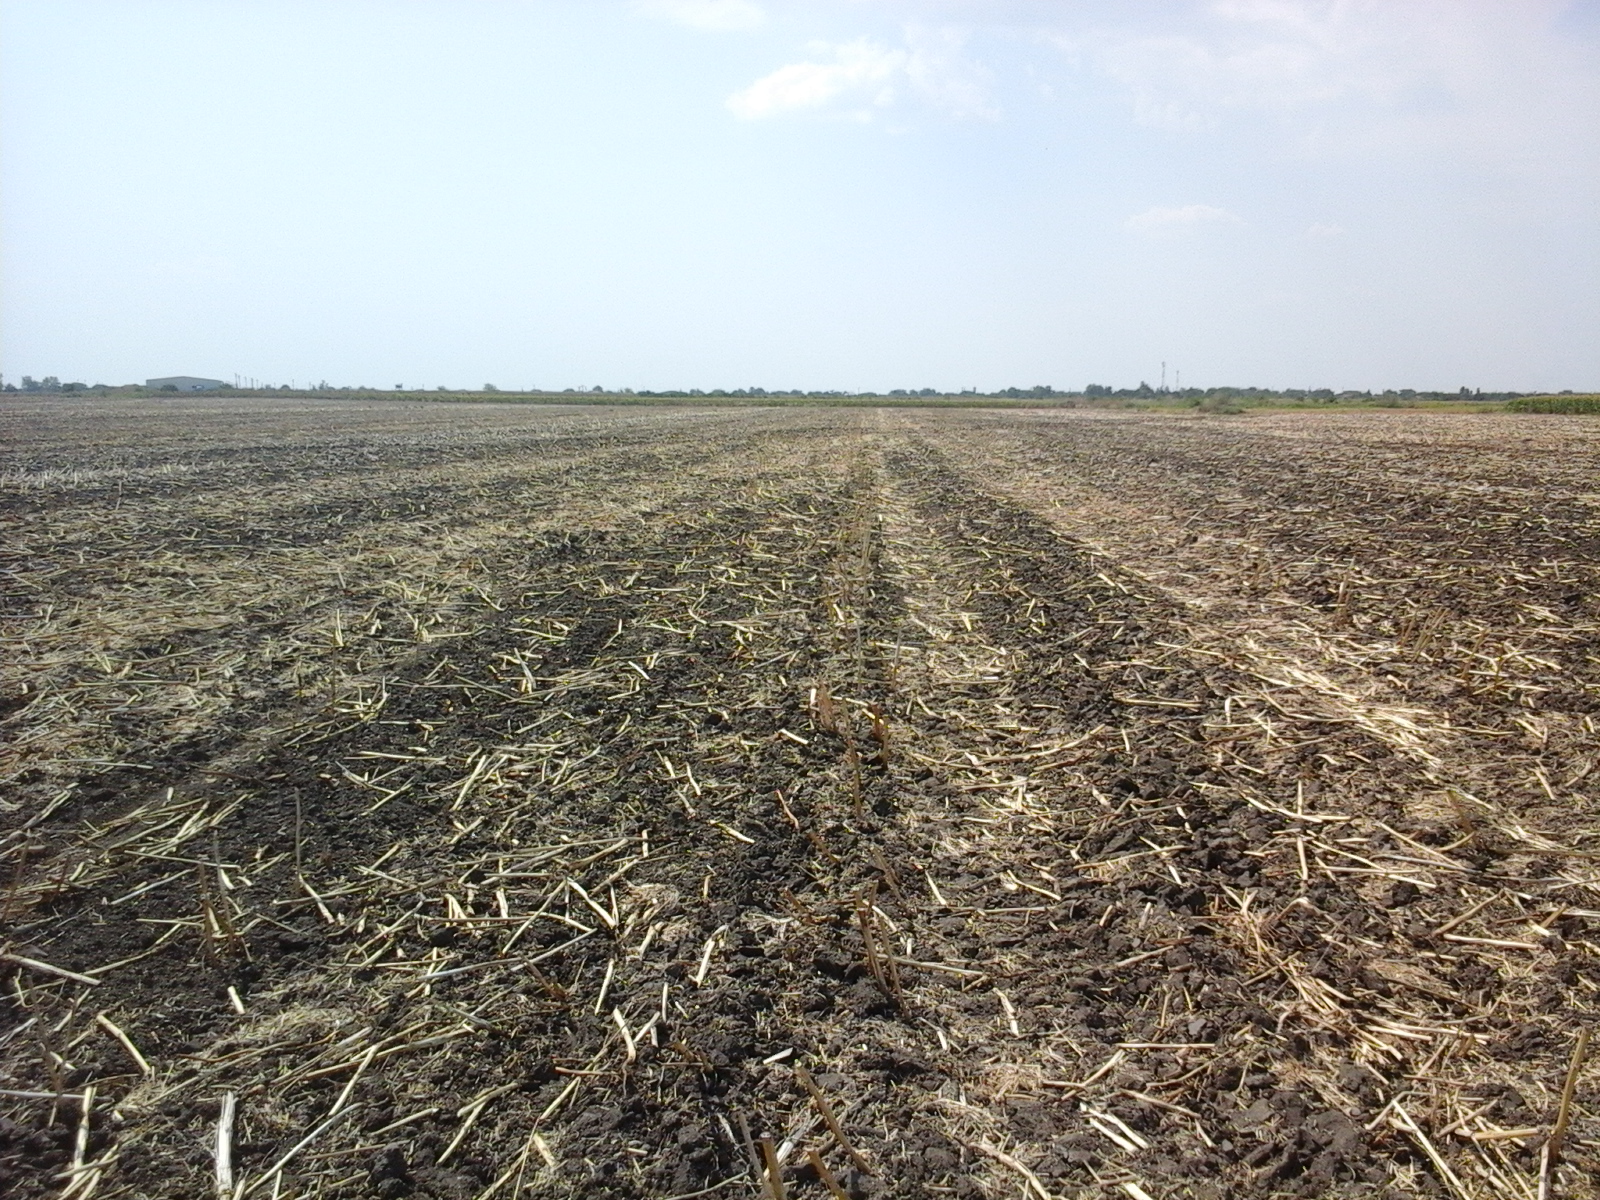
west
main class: Cropland
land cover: Rape and turnip rape
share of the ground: < 10 %
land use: Agriculture (excluding fallow land and kitchen gardens)
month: August
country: RO
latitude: 43.9203
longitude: 23.6382
